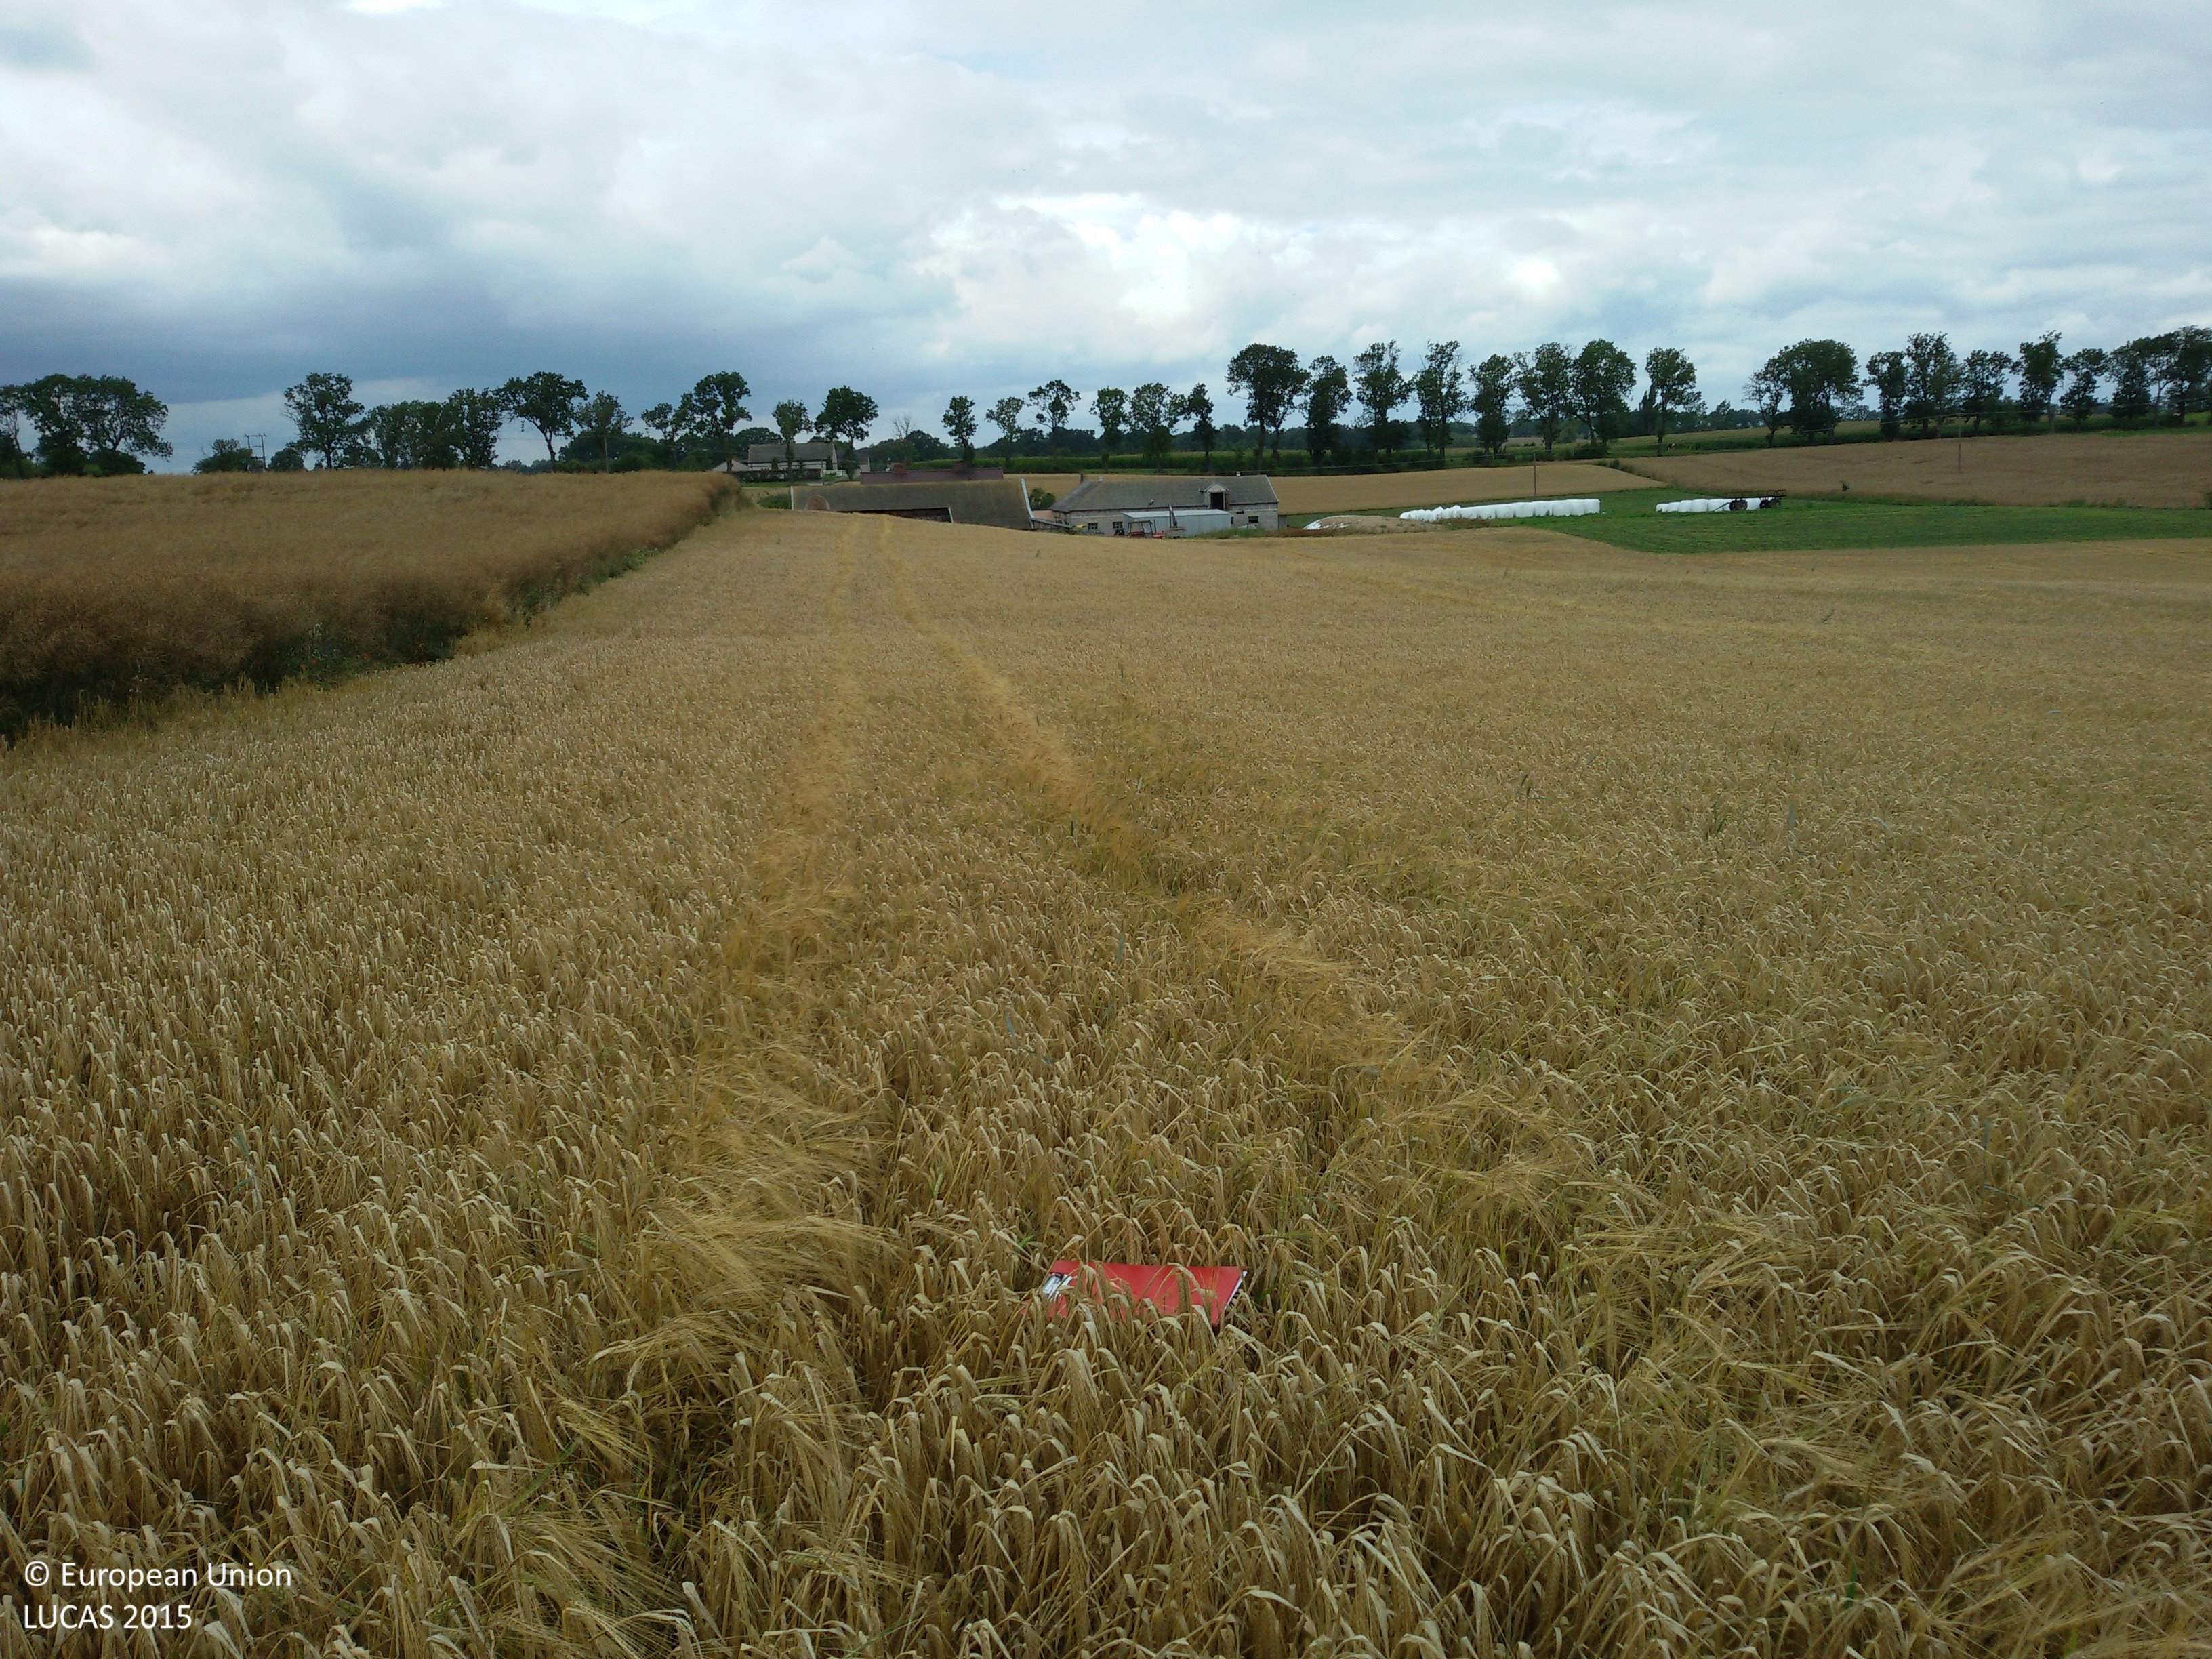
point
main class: Cropland
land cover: Barley
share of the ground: > 75 %
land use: Agriculture (excluding fallow land and kitchen gardens)
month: July
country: PL
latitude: 52.9845
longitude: 19.1248
